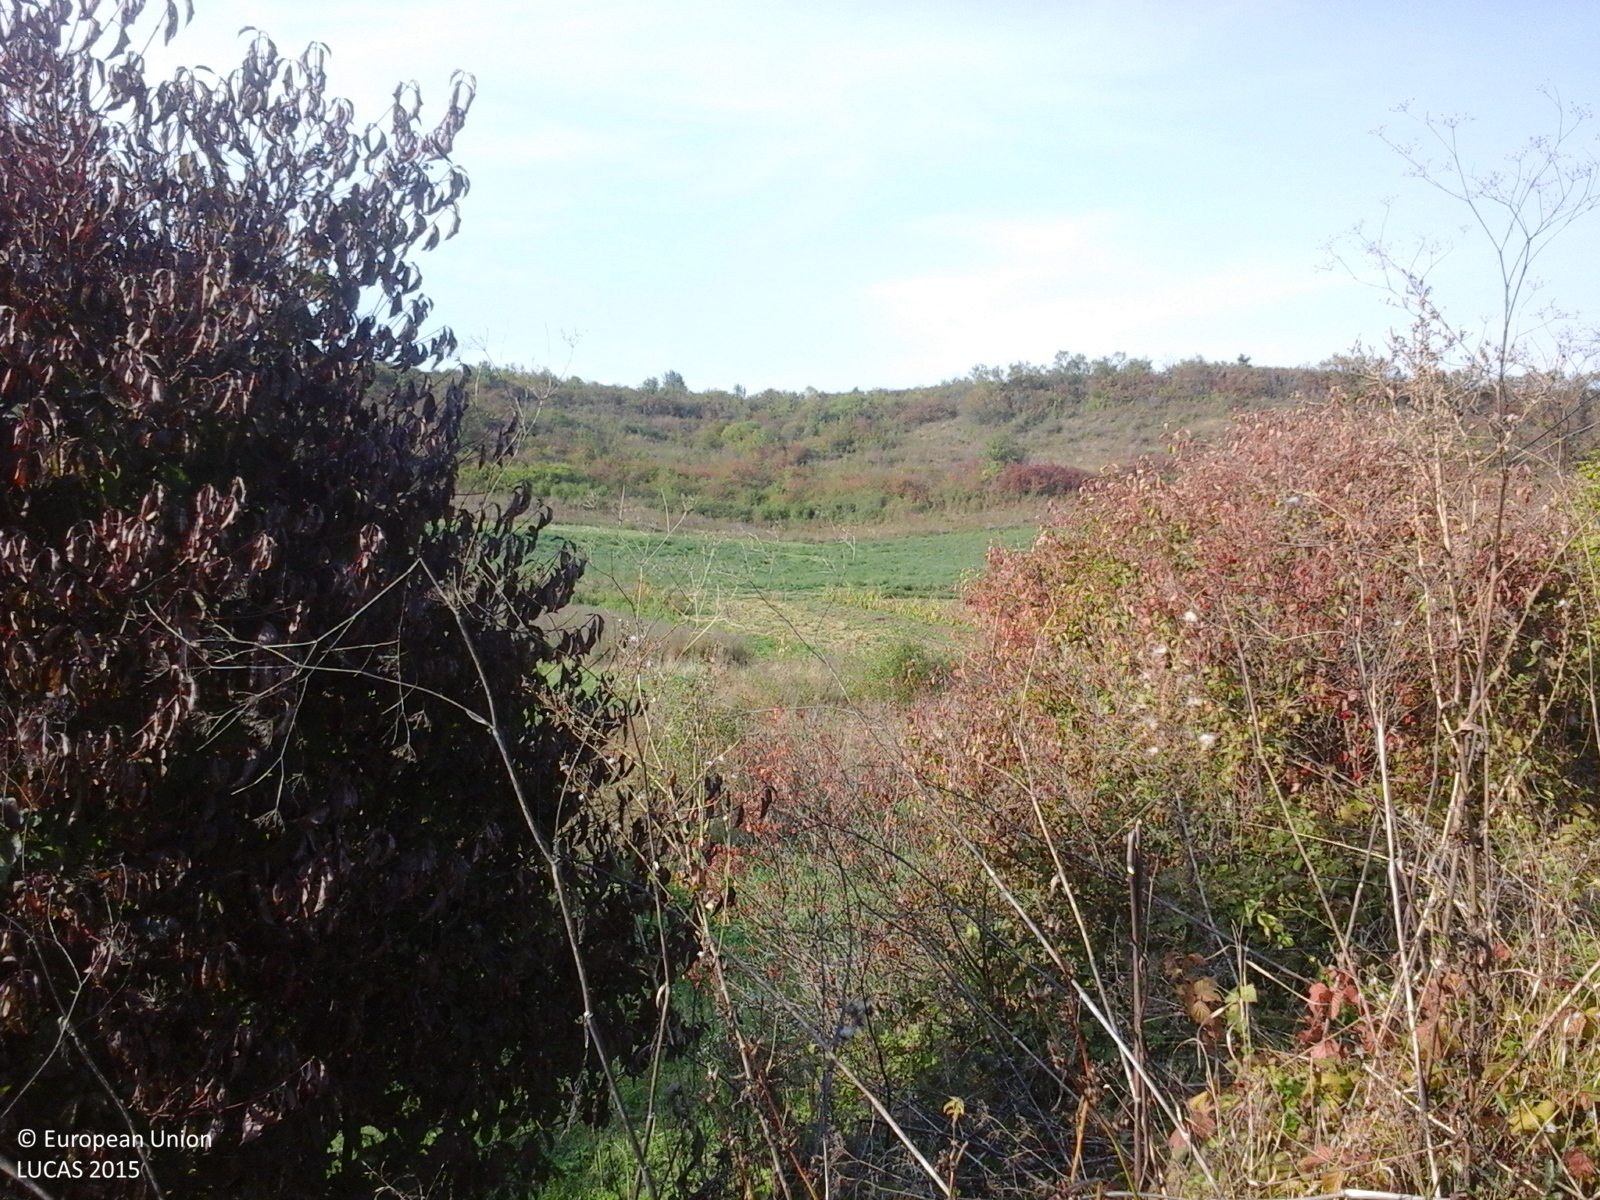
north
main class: Shrubland
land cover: Shrubland without tree cover
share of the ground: > 75 %
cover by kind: shrubs 100 %
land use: Fallow land
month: September
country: RO
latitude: 47.0040
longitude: 23.3652
